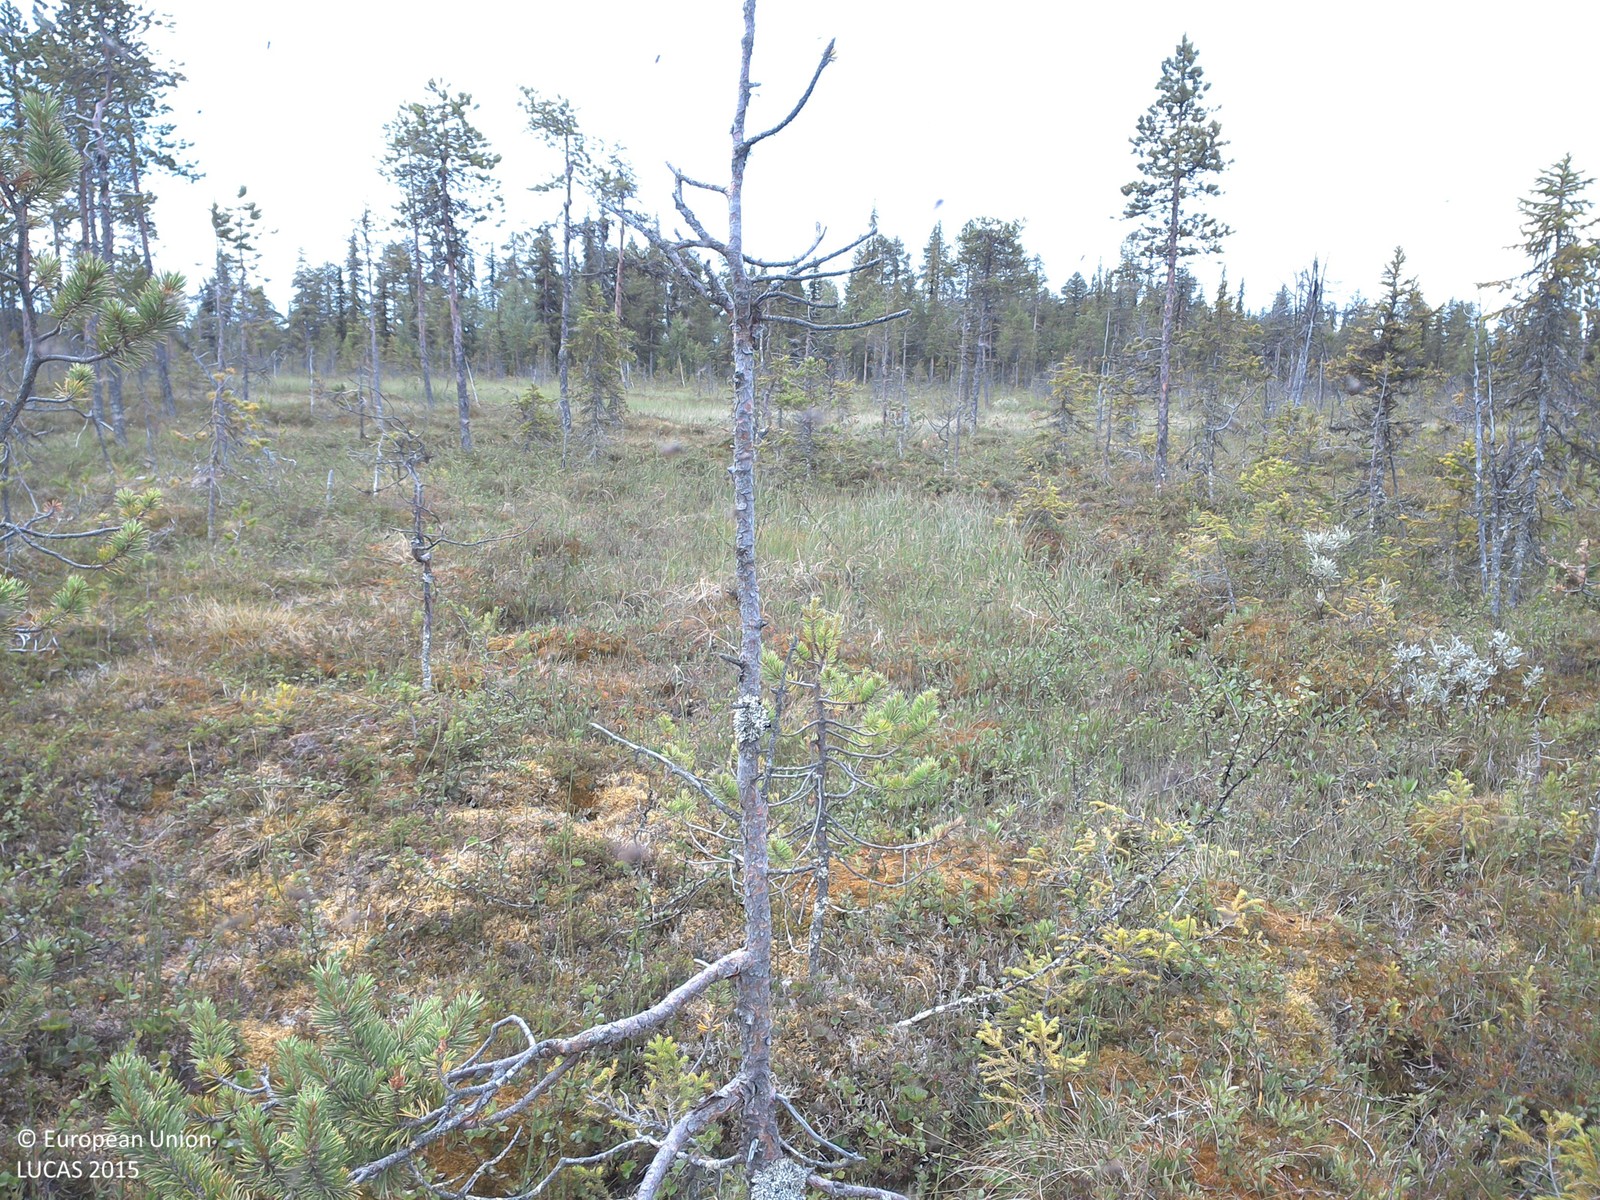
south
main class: Woodland
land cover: Spruce dominated coniferous woodland
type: boreal forest
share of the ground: 10 - 25 %
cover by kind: lichens and mosses 45 %, shrubs 25 %, herbaceous plants 20 %, coniferous forest trees 10 %
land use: Forestry
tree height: < 5 m
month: July
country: SE
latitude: 67.6897
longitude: 21.0624
